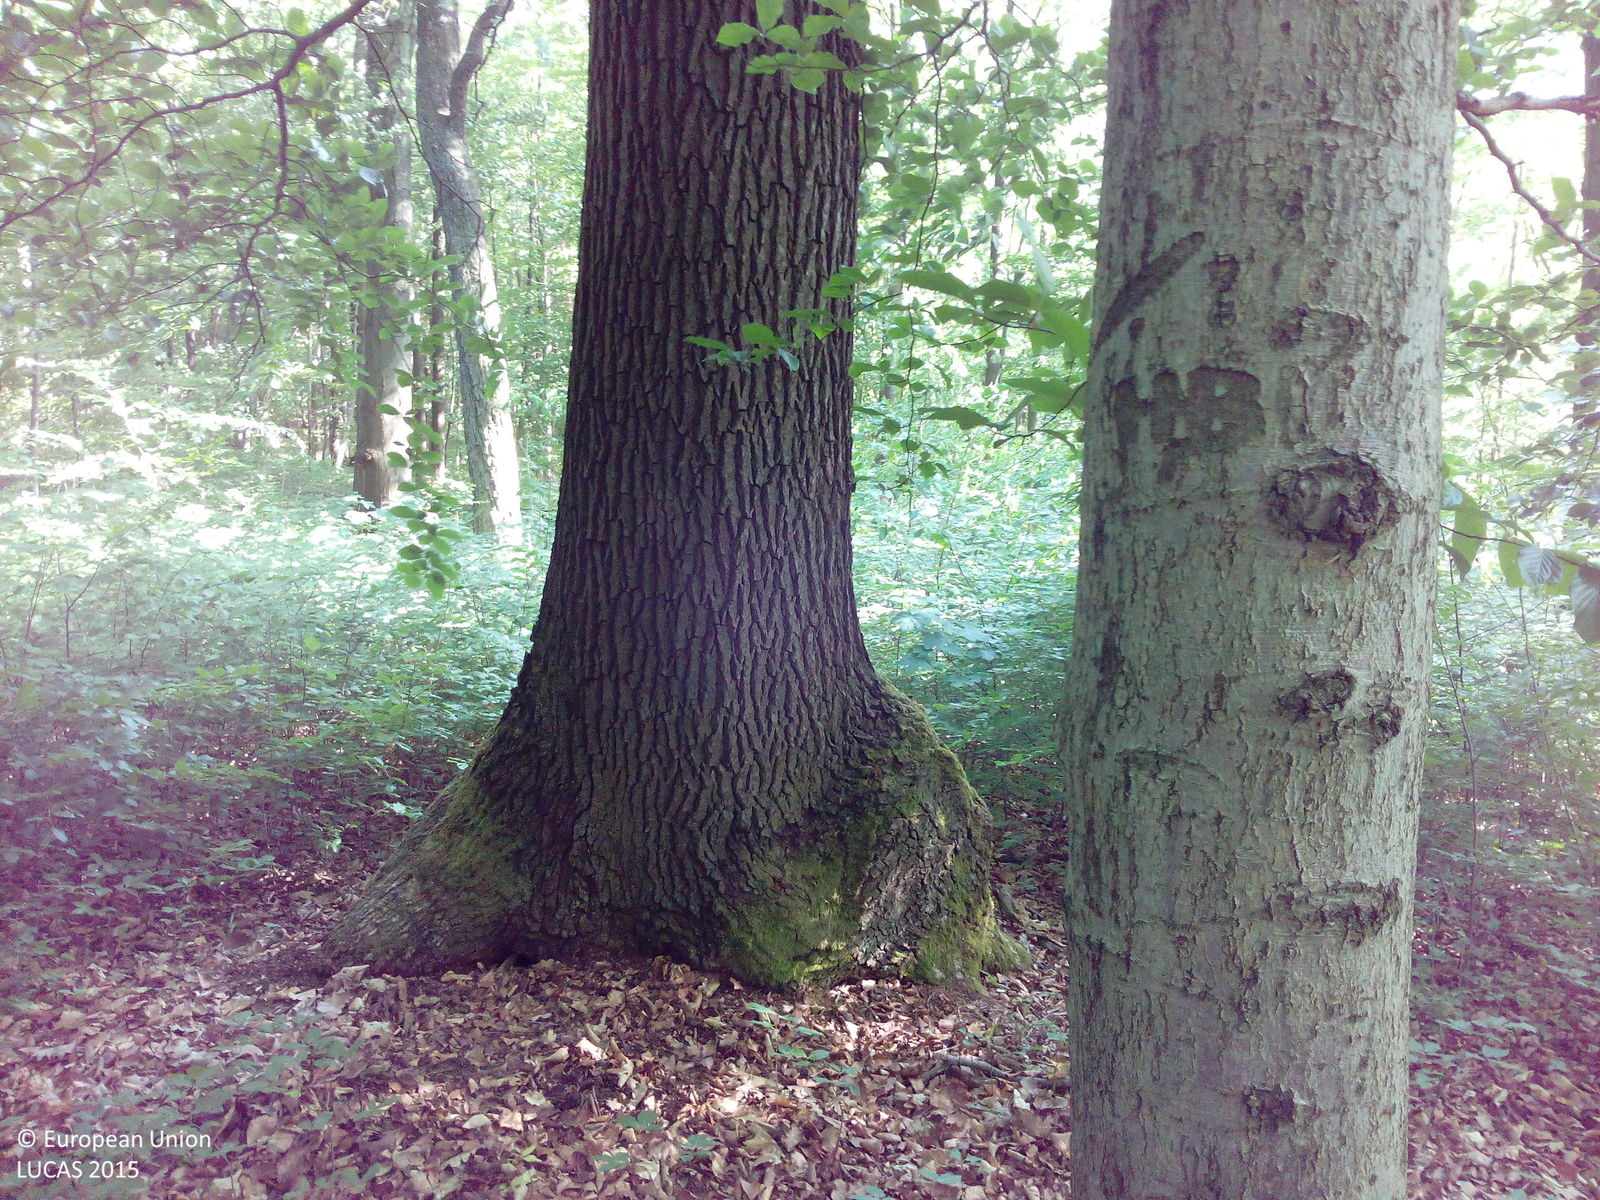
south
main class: Woodland
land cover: Broadleaved woodland
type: beech forest
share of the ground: > 75 %
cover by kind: broadleaved forest trees 85 %, unconsolidated bare surface 10 %, shrubs 5 %
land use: Forestry
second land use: Amenities, museums, leisure
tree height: > 5 m
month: June
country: DE
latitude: 50.7863
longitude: 11.4606
